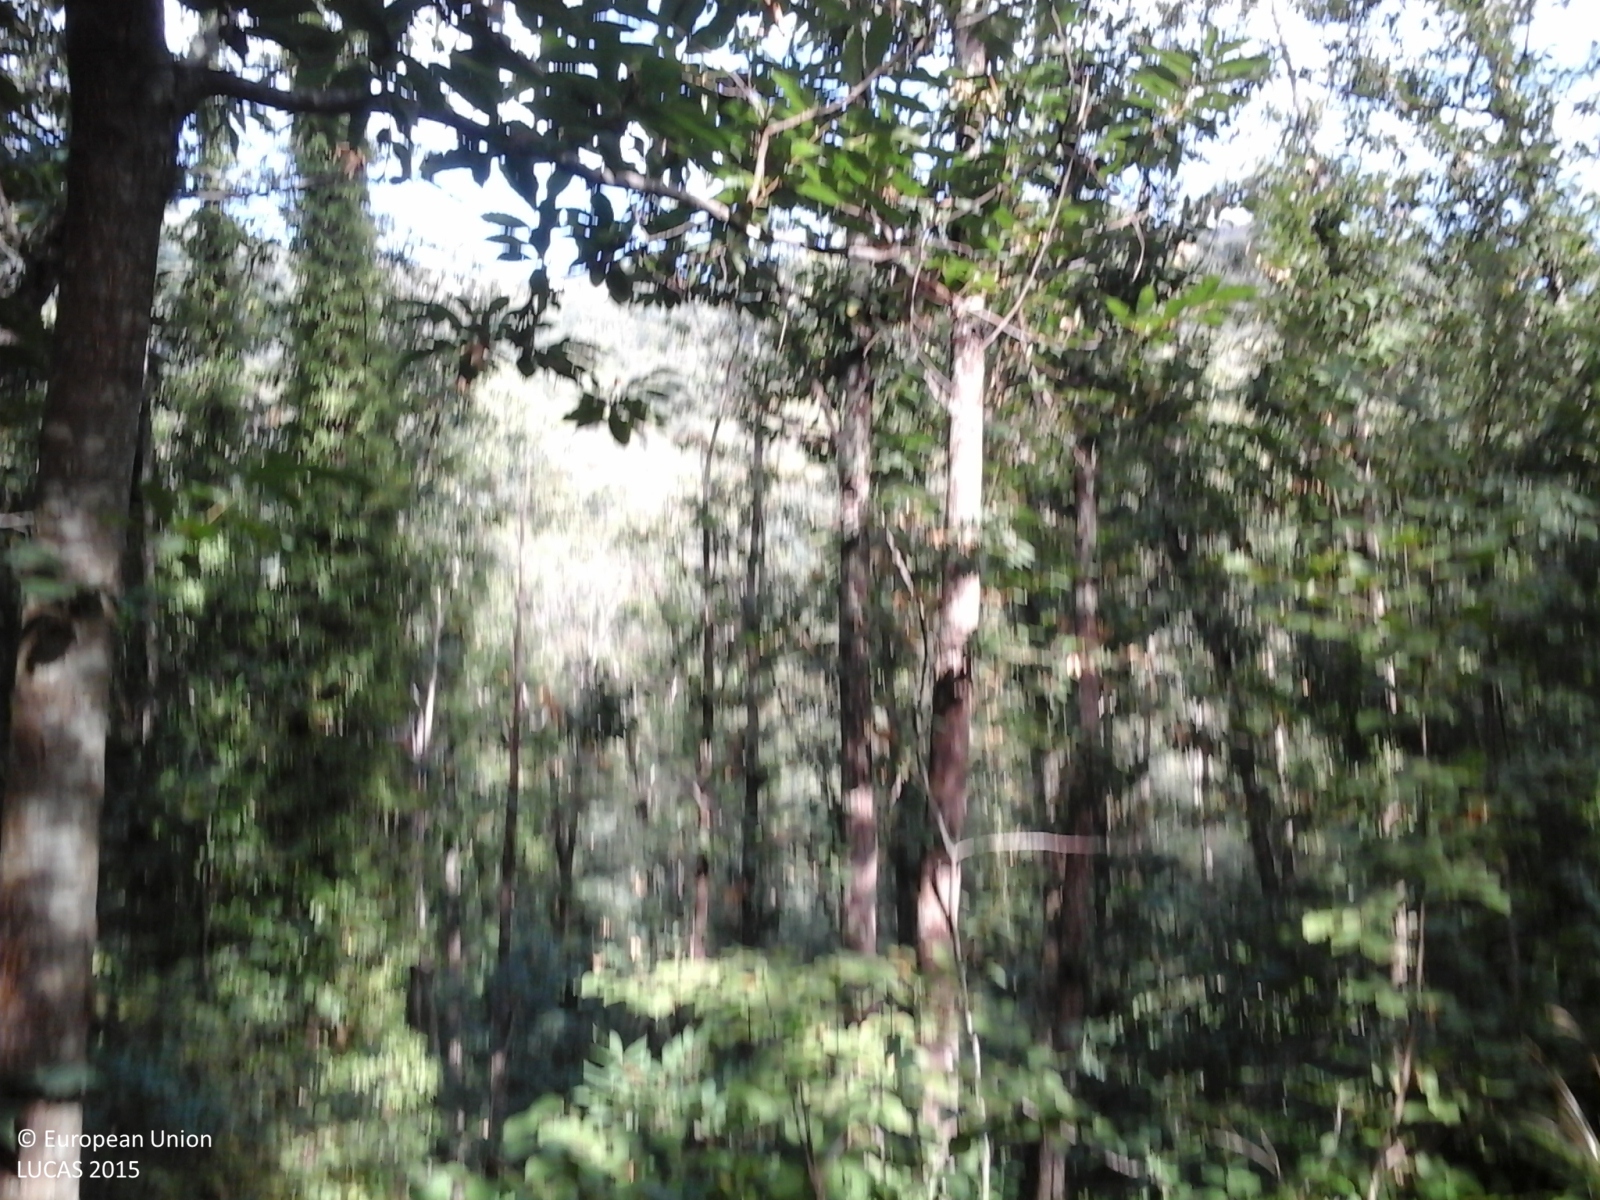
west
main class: Woodland
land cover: Broadleaved woodland
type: mesophytic deciduous forest
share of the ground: > 75 %
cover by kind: broadleaved forest trees 85 %, herbaceous plants 10 %, shrubs 5 %
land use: Forestry
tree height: > 5 m
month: July
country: IT
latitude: 44.2062
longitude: 9.8627
